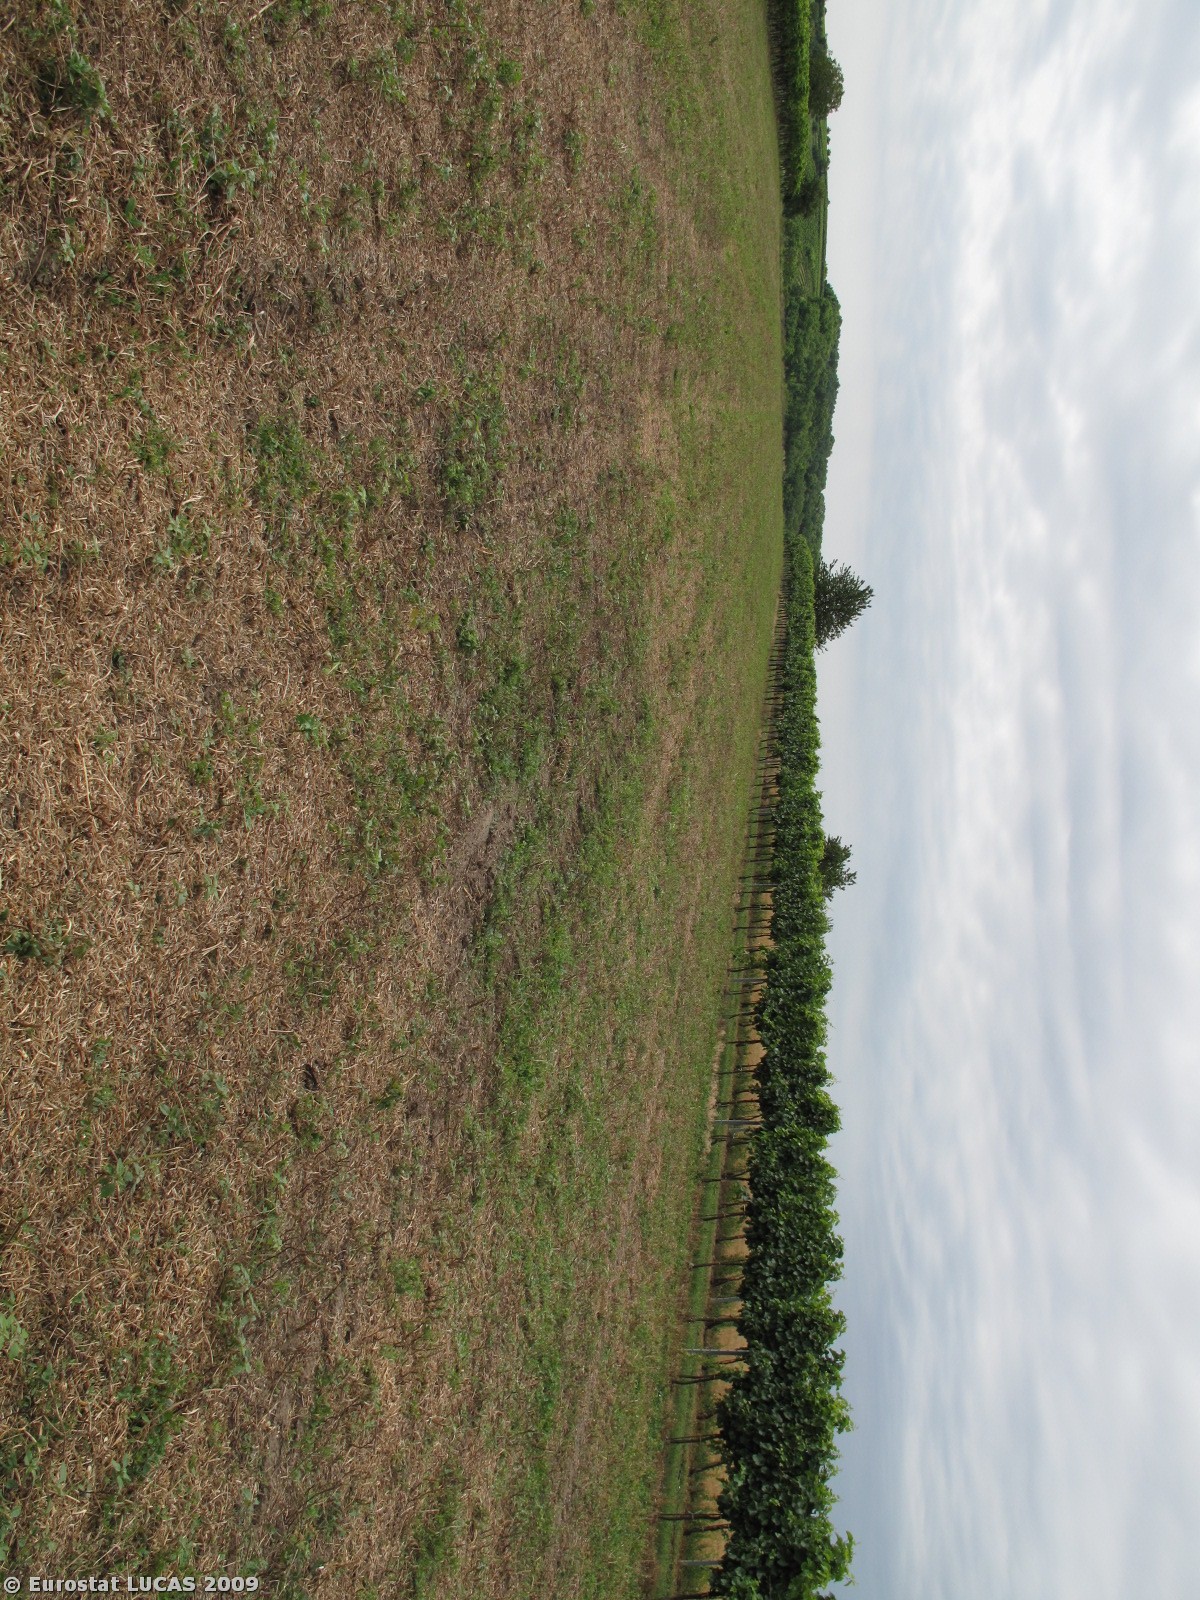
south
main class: Cropland
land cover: Dry pulses
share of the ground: 50 - 75 %
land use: Agriculture (excluding fallow land and kitchen gardens)
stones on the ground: < 10 %
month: May
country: AT
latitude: 48.6889
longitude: 16.0497
